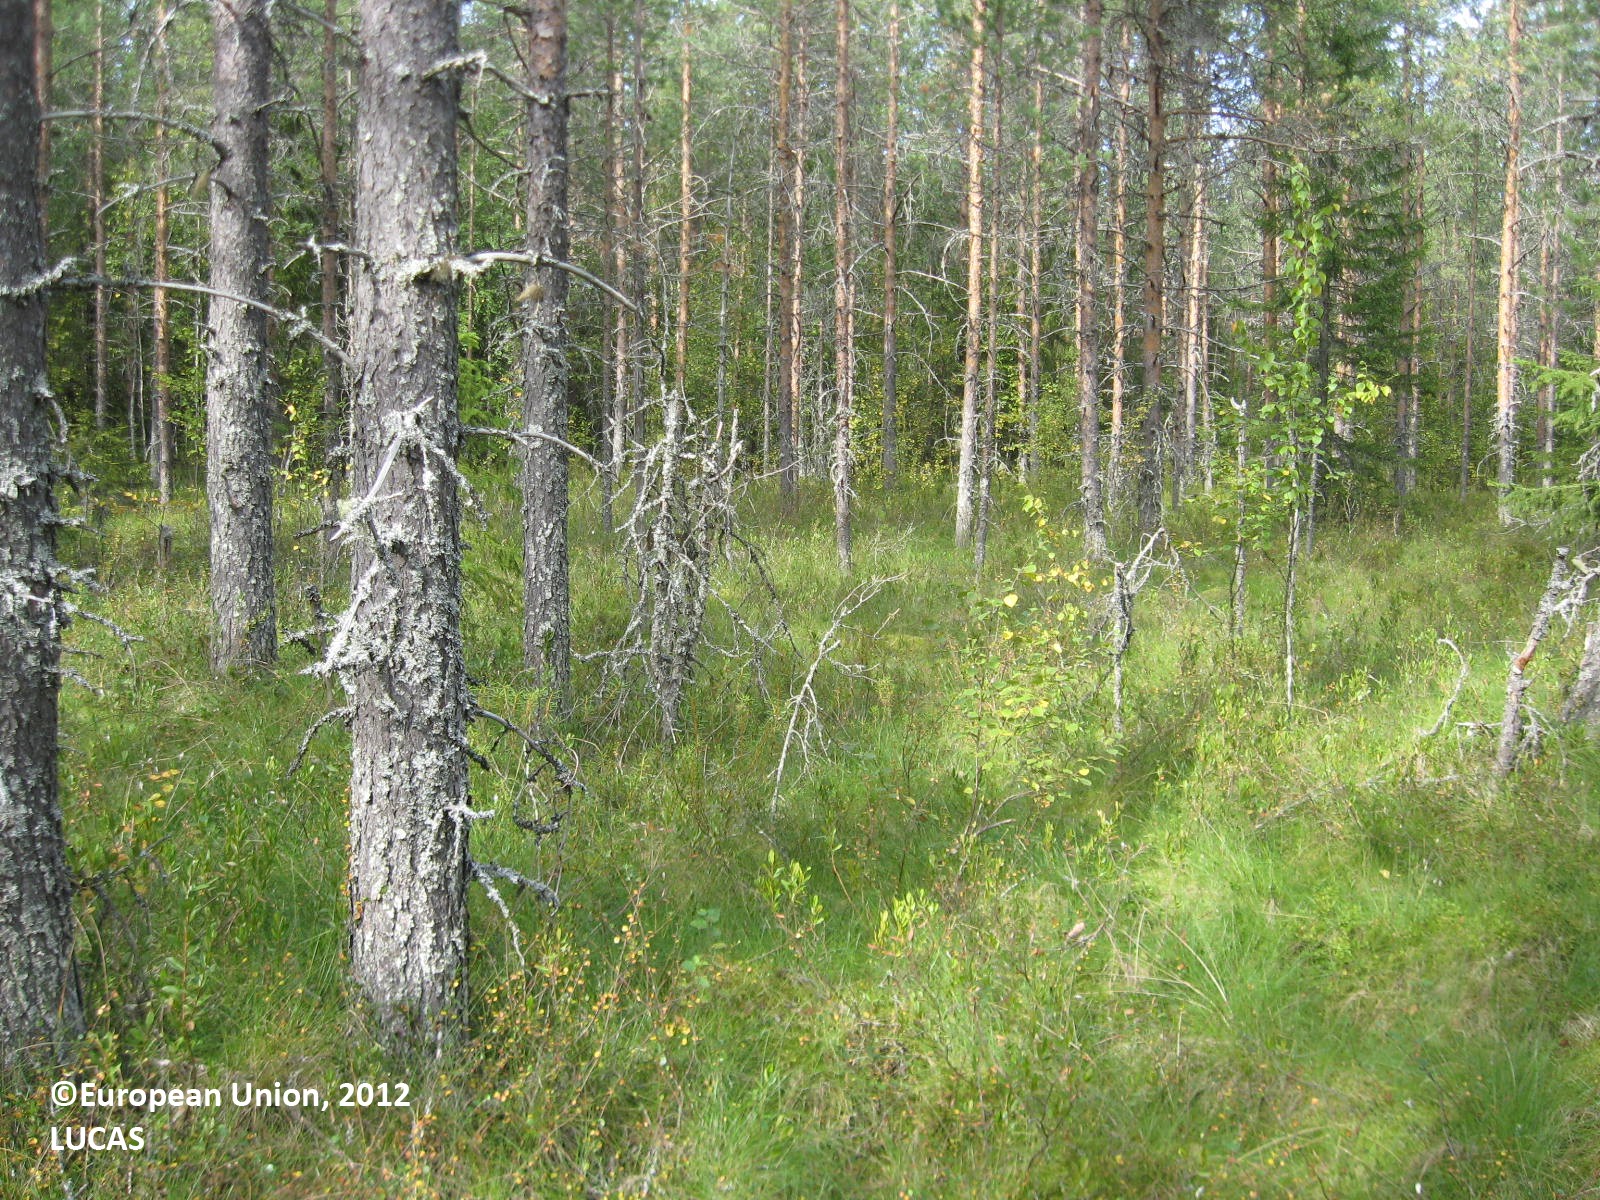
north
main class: Woodland
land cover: Pine dominated mixed woodland
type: boreal forest
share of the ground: 50 - 75 %
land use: Forestry
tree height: > 5 m
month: August
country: FI
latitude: 63.8425
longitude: 29.0525
